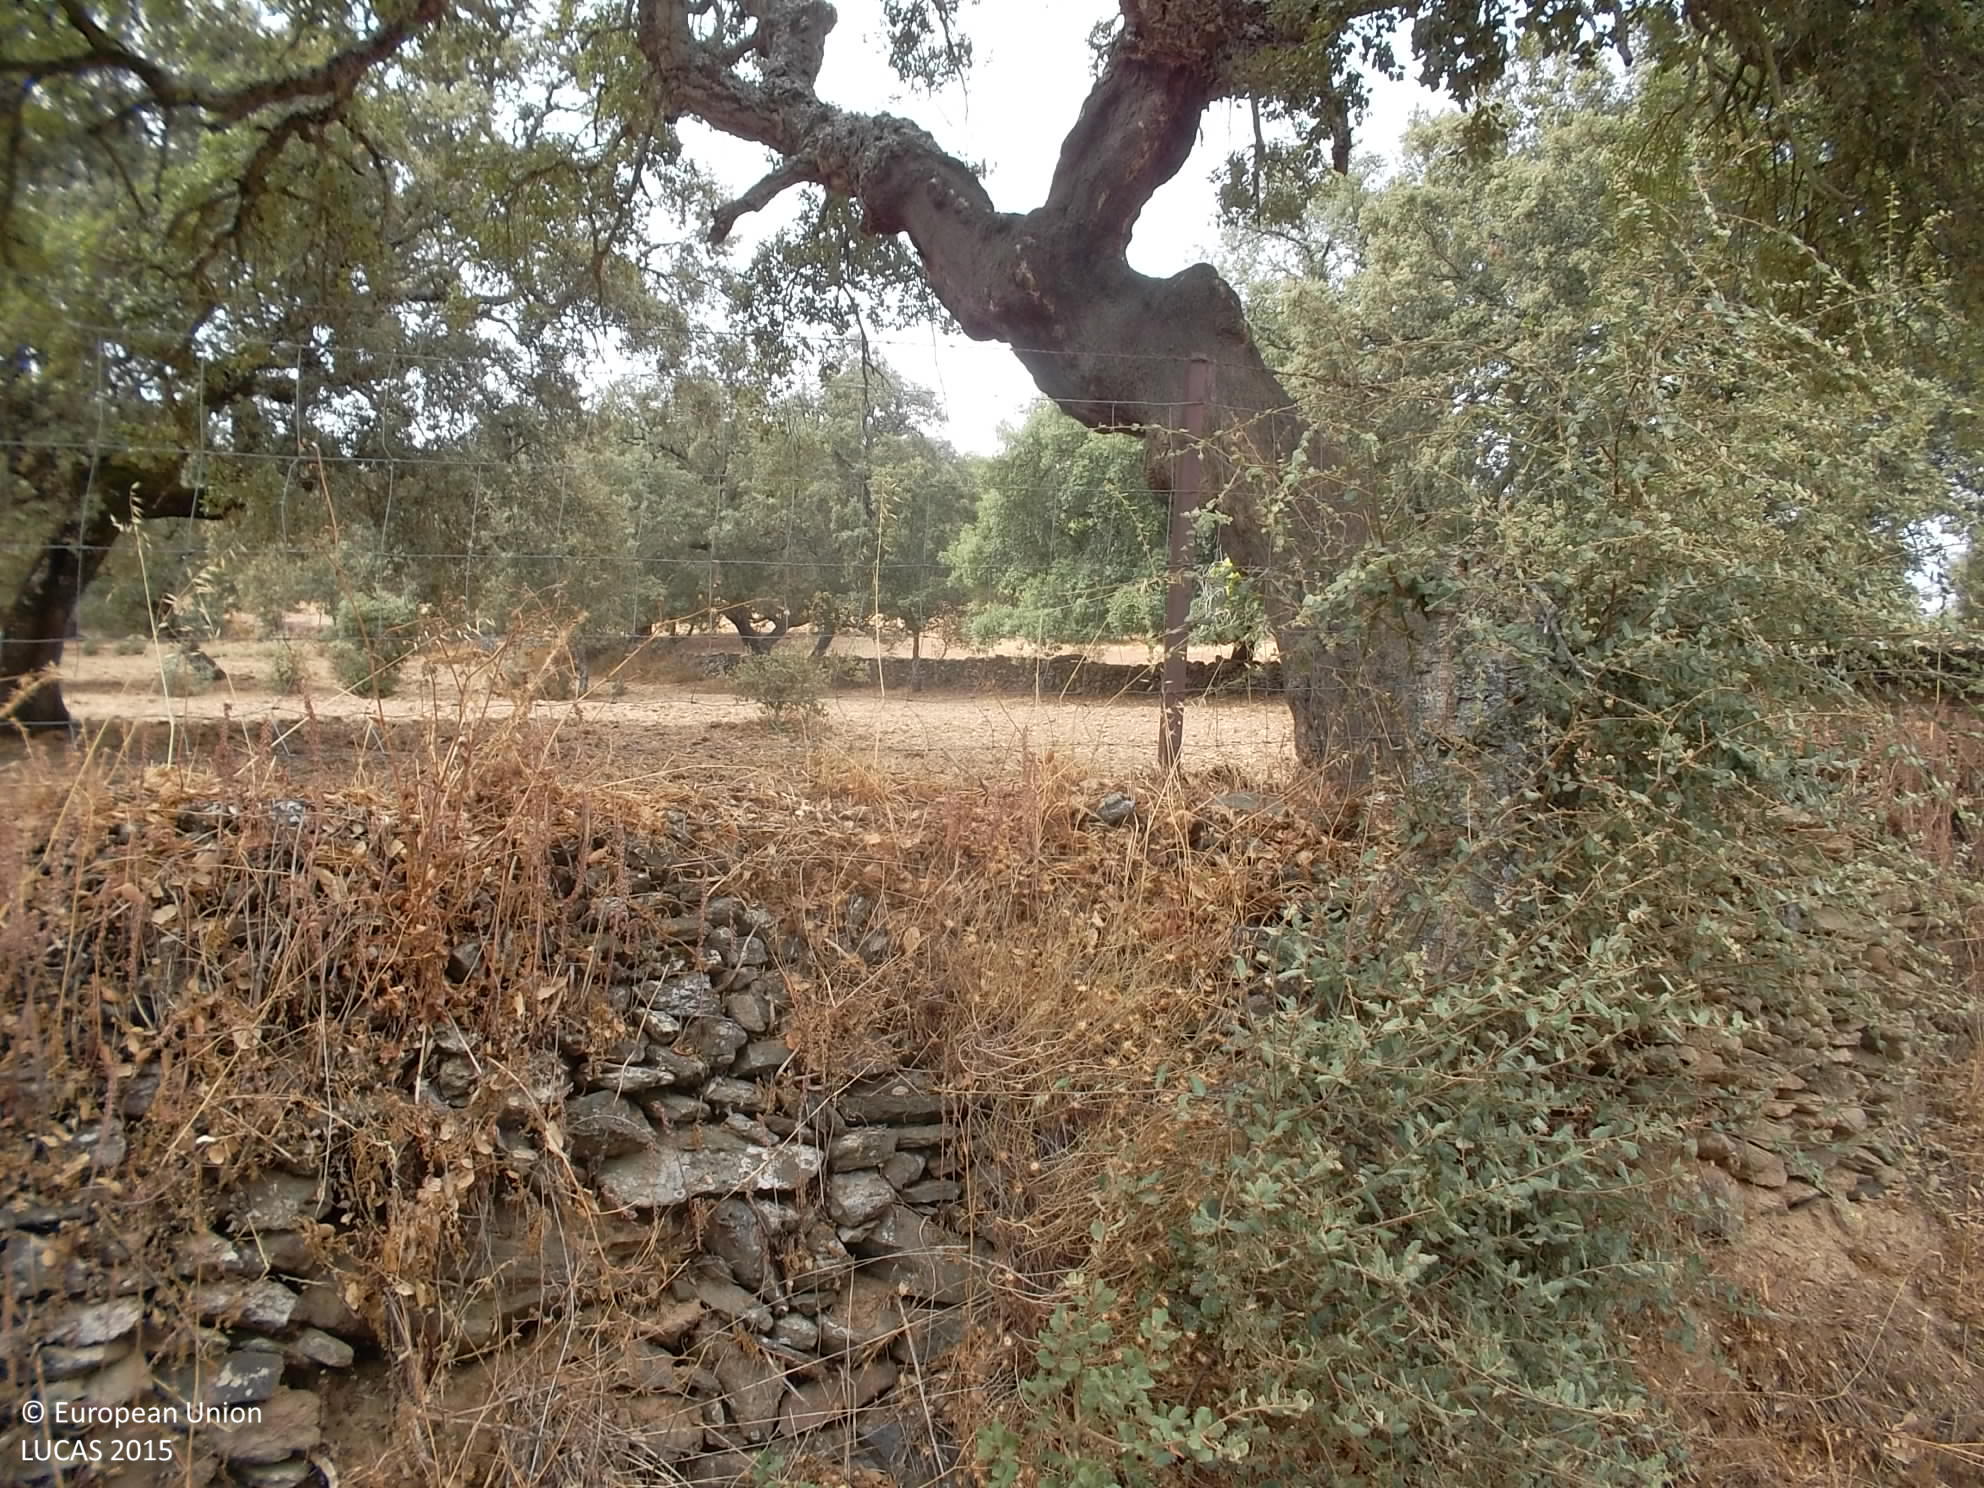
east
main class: Woodland
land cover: Broadleaved woodland
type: broadleaved evergreen forest
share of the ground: 25 - 50 %
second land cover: Grassland without tree/shrub cover
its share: > 75 %
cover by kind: herbaceous plants 75 %, broadleaved forest trees 25 %
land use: Forestry
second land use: Agriculture (excluding fallow land and kitchen gardens)
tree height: > 5 m
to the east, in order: Broadleaved woodland; Grassland without tree/shrub cover; Fences; Dry stone walls; Grass margins; Paved roads, cycling and walking lanes; Grass margins; Dry stone walls; Fences; Grassland without tree/shrub cover; Single bushes/trees; Grassland without tree/shrub cover; Fences; Grassland with sparse tree/shrub cover; Dry stone walls; Broadleaved woodland
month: September
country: ES
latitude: 38.0774
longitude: -6.3331
